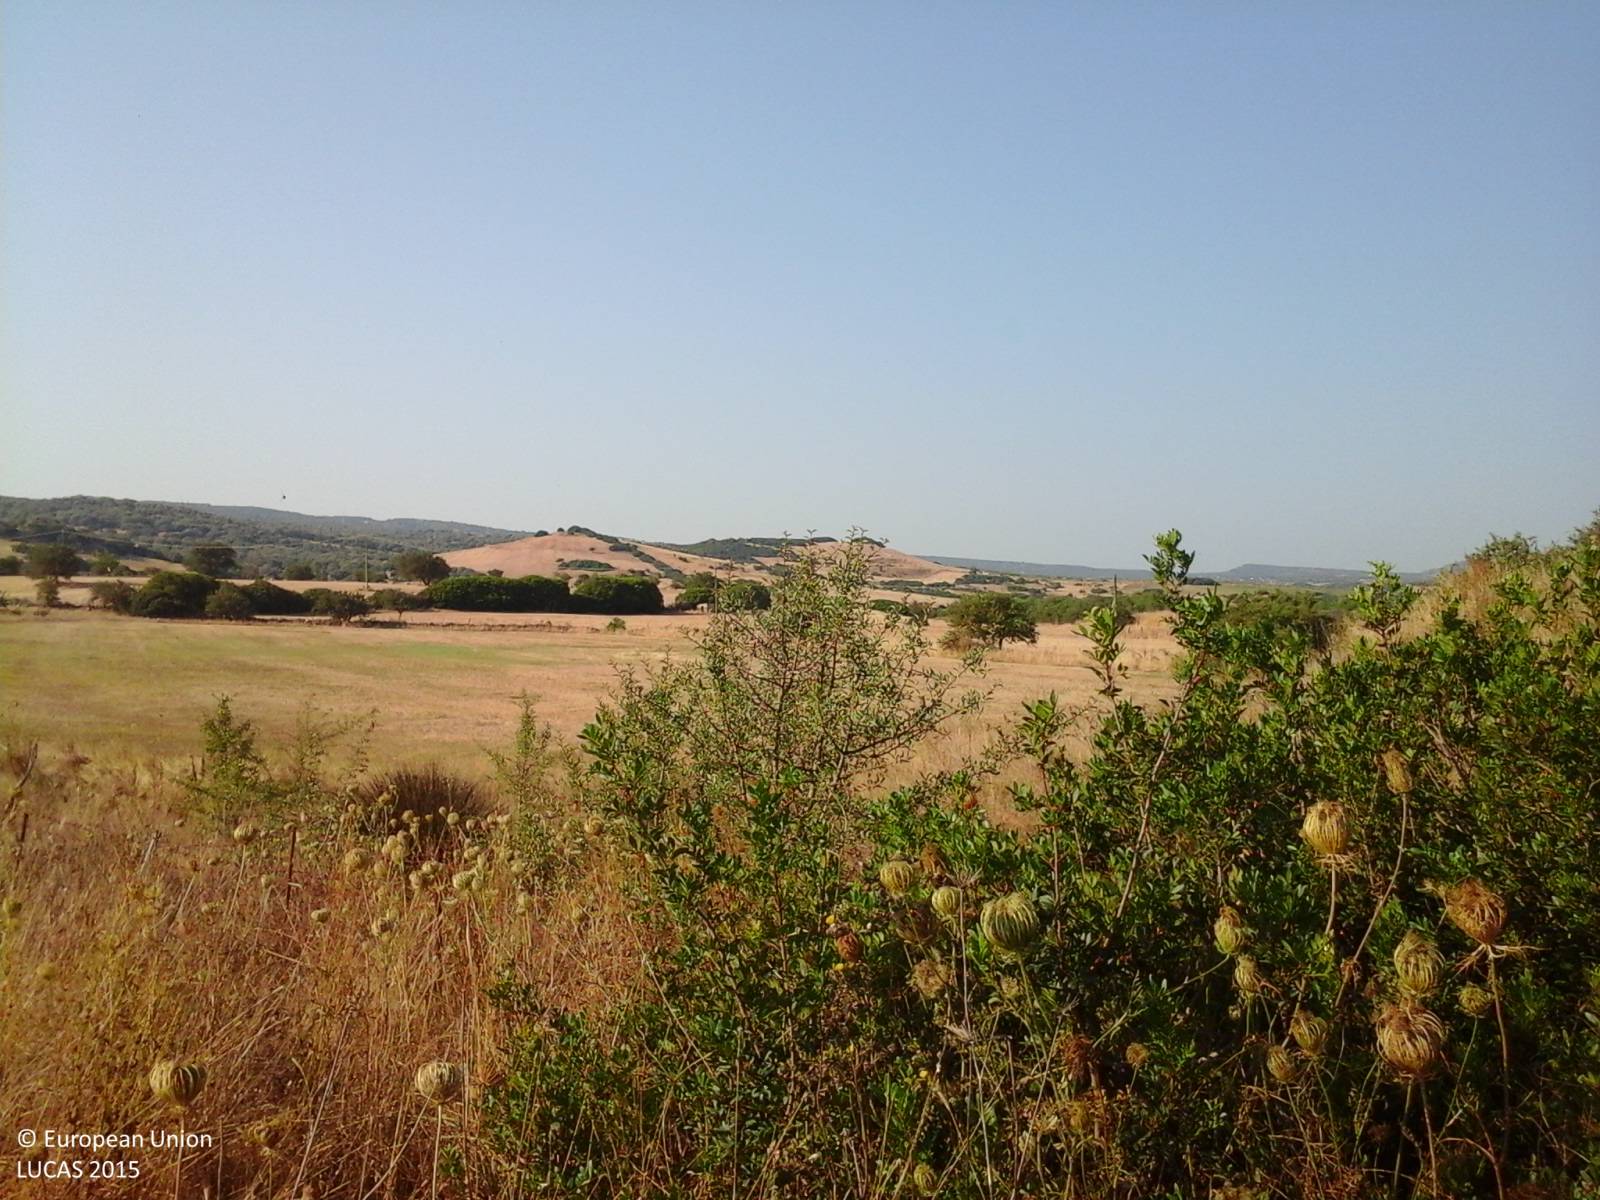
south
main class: Shrubland
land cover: Shrubland with sparse tree cover
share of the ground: > 75 %
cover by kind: herbaceous plants 80 %, shrubs 15 %, broadleaved forest trees 5 %
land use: Agriculture (excluding fallow land and kitchen gardens)
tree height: < 5 m
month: July
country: IT
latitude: 40.8222
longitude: 8.9026
